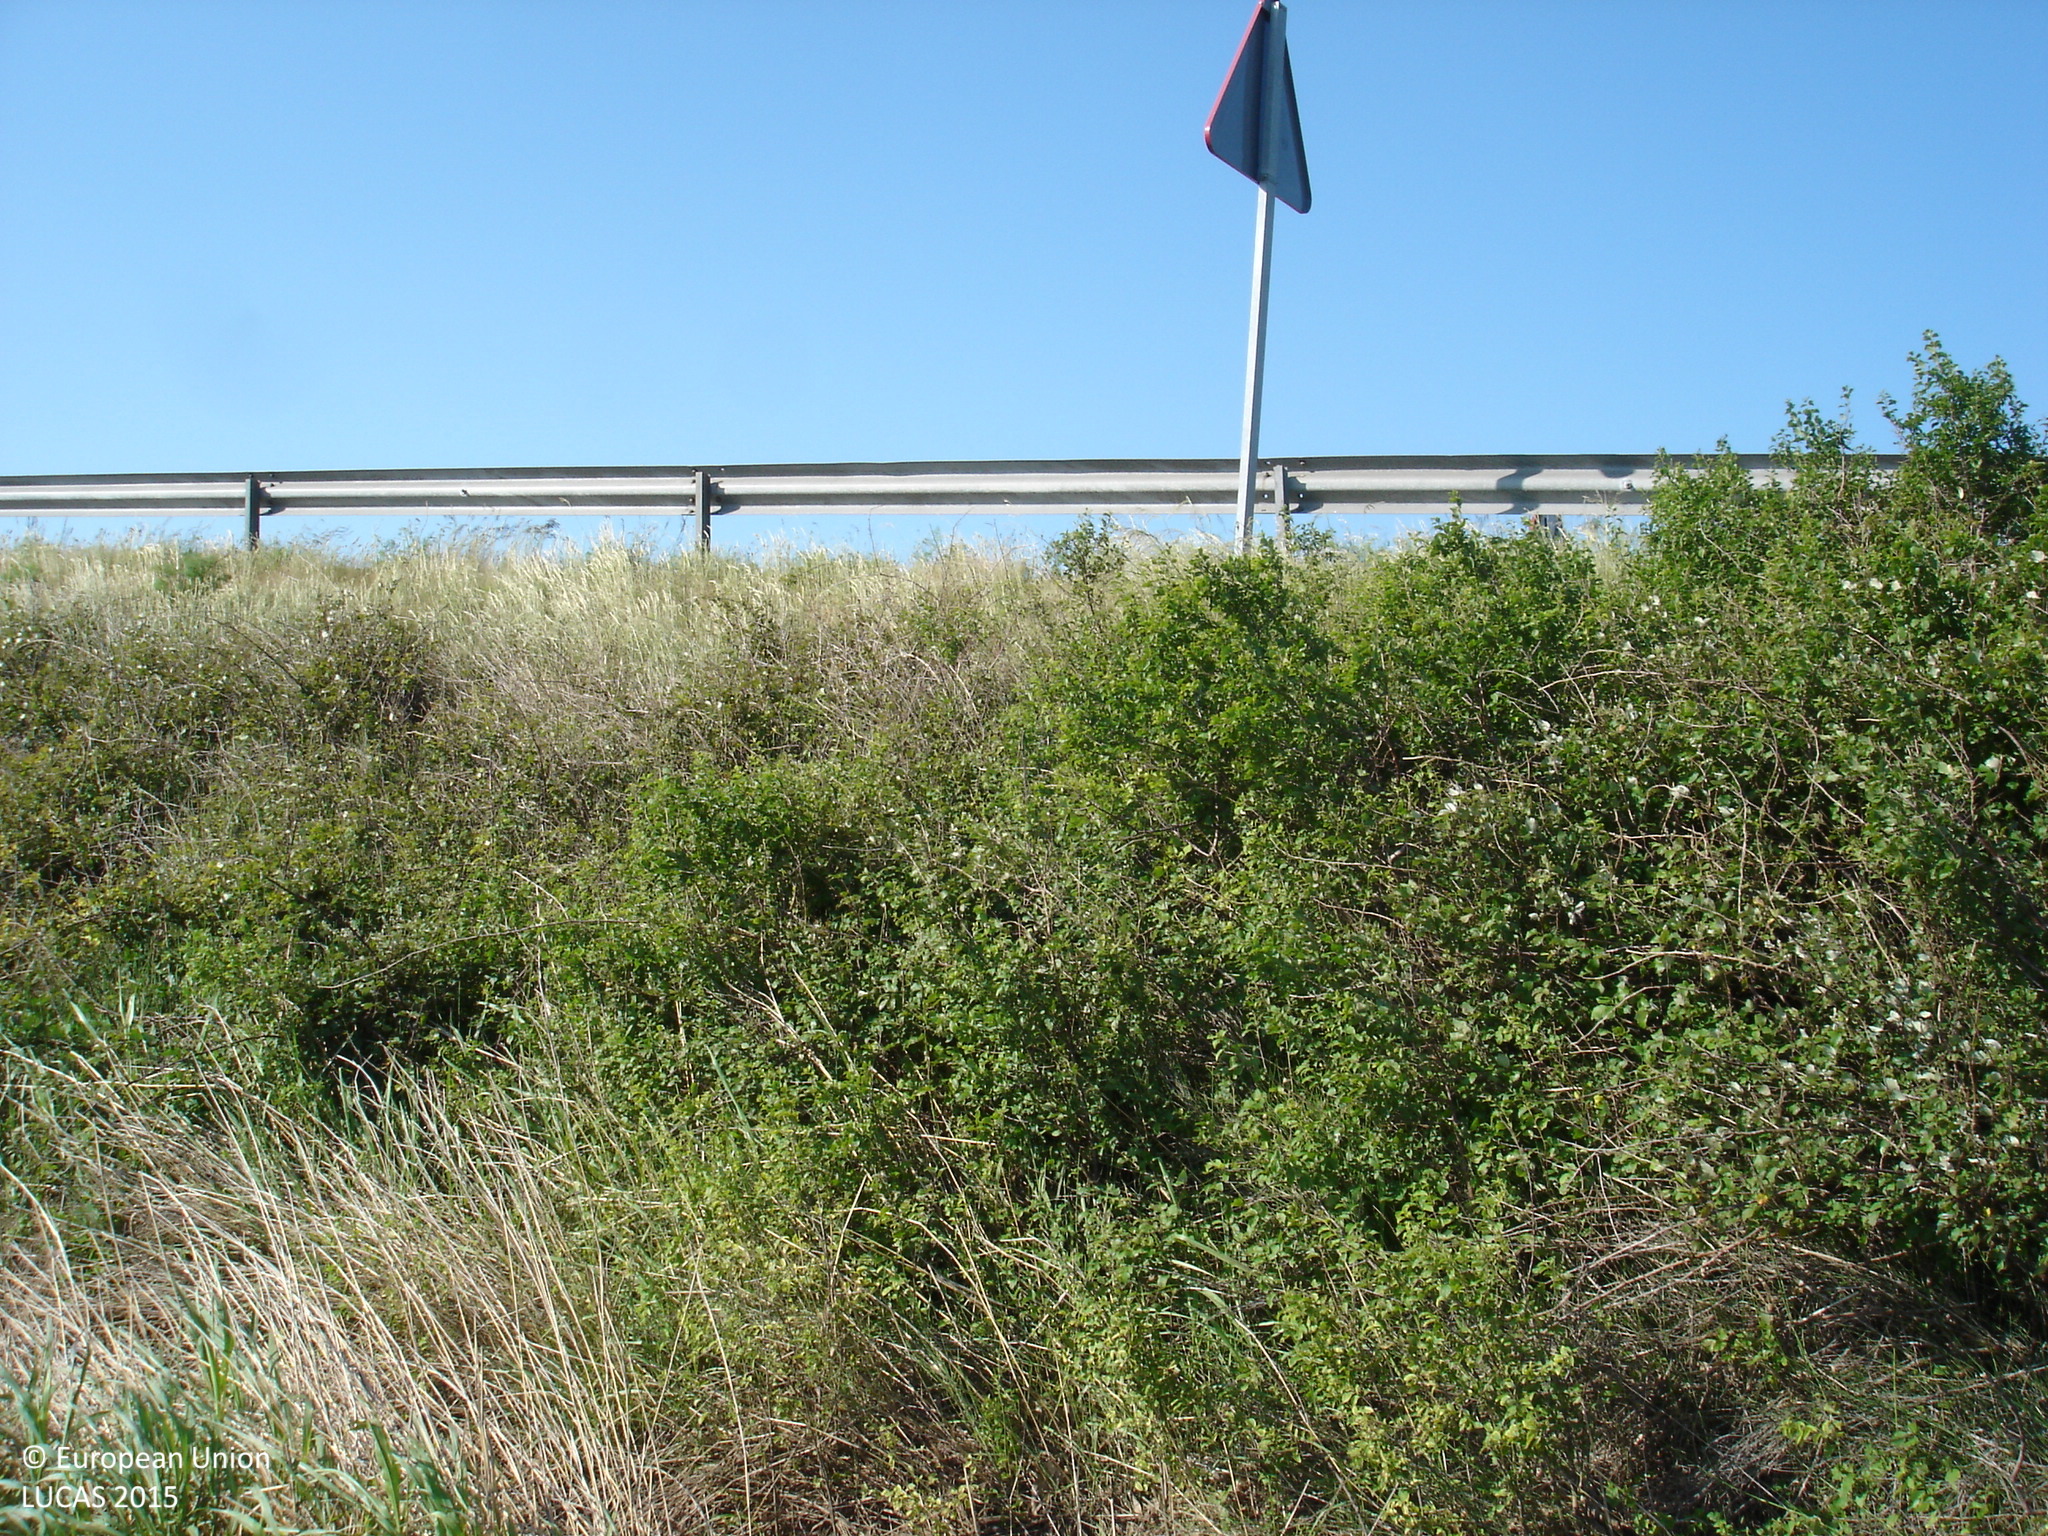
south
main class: Cropland
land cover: Maize
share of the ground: 25 - 50 %
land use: Agriculture (excluding fallow land and kitchen gardens)
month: May
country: ES
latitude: 42.2826
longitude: 2.9686
